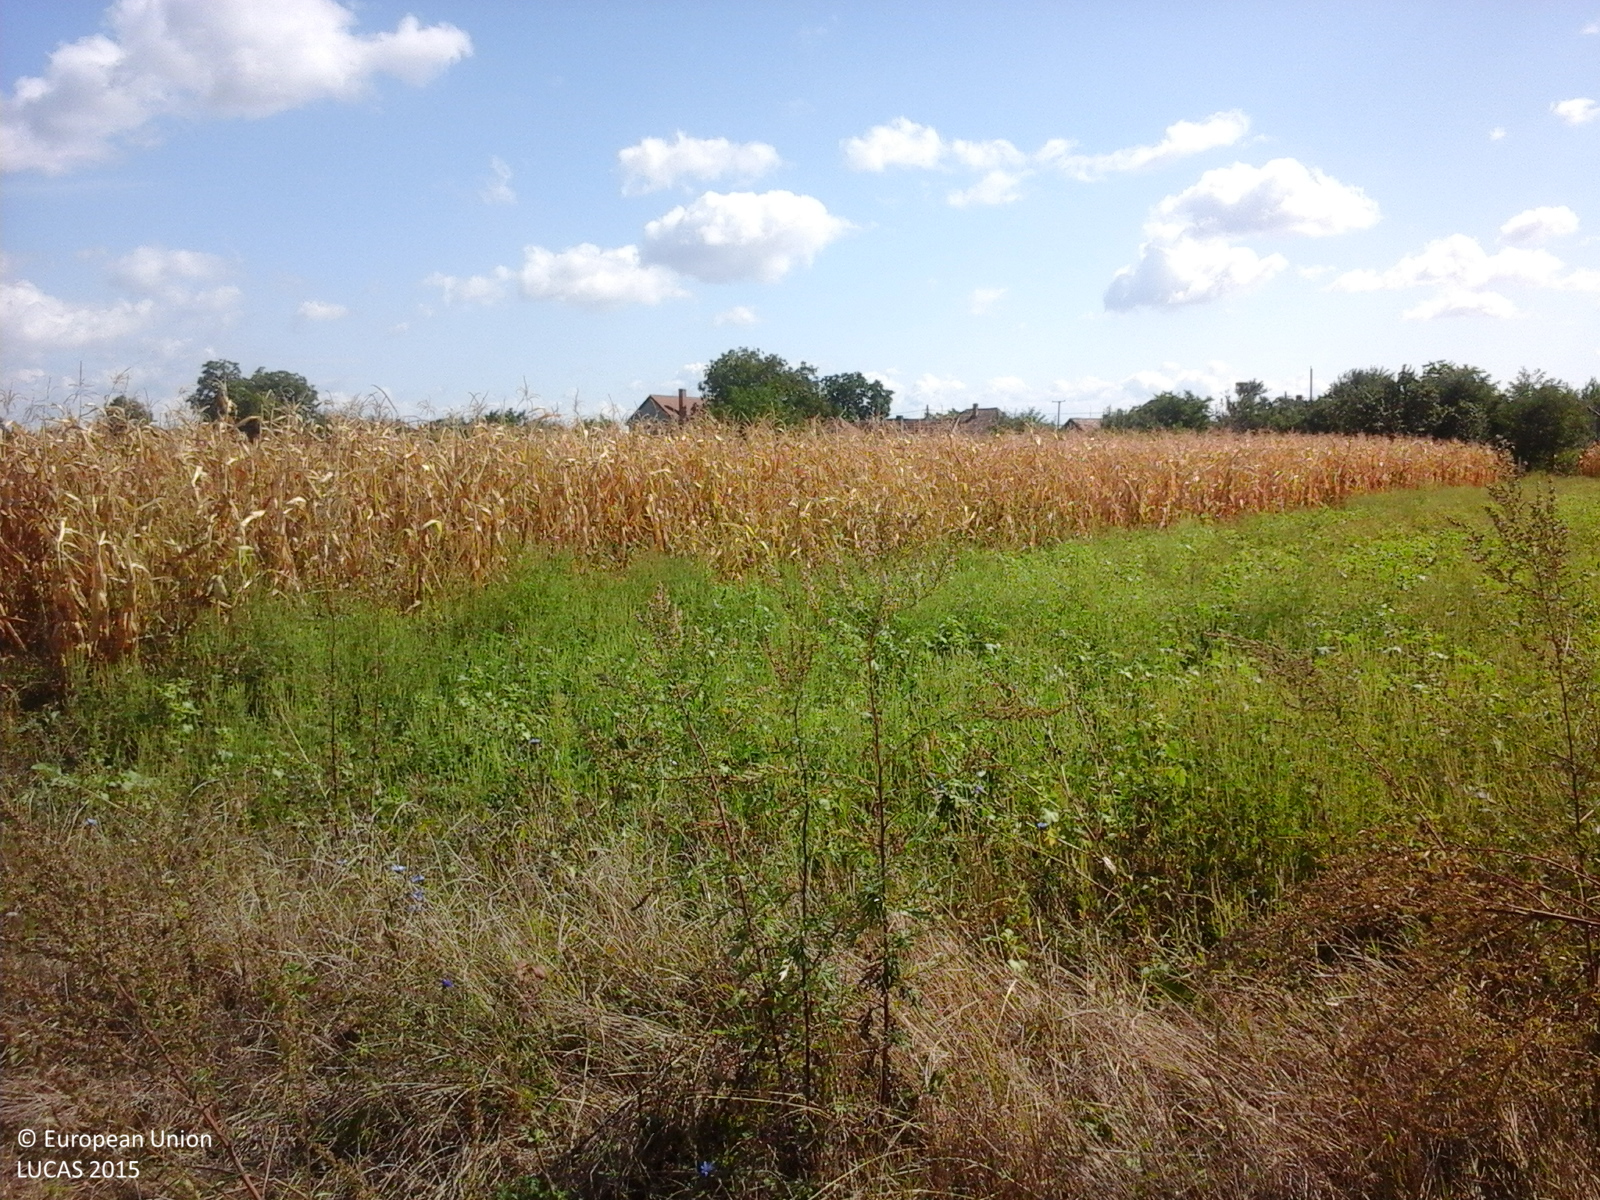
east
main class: Cropland
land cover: Maize
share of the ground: > 75 %
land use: Agriculture (excluding fallow land and kitchen gardens)
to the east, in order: Maize; Tracks; Spontaneously vegetated surfaces; Maize; Artificial constructions in urban areas; Maize
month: September
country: RO
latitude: 47.7989
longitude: 22.9766
